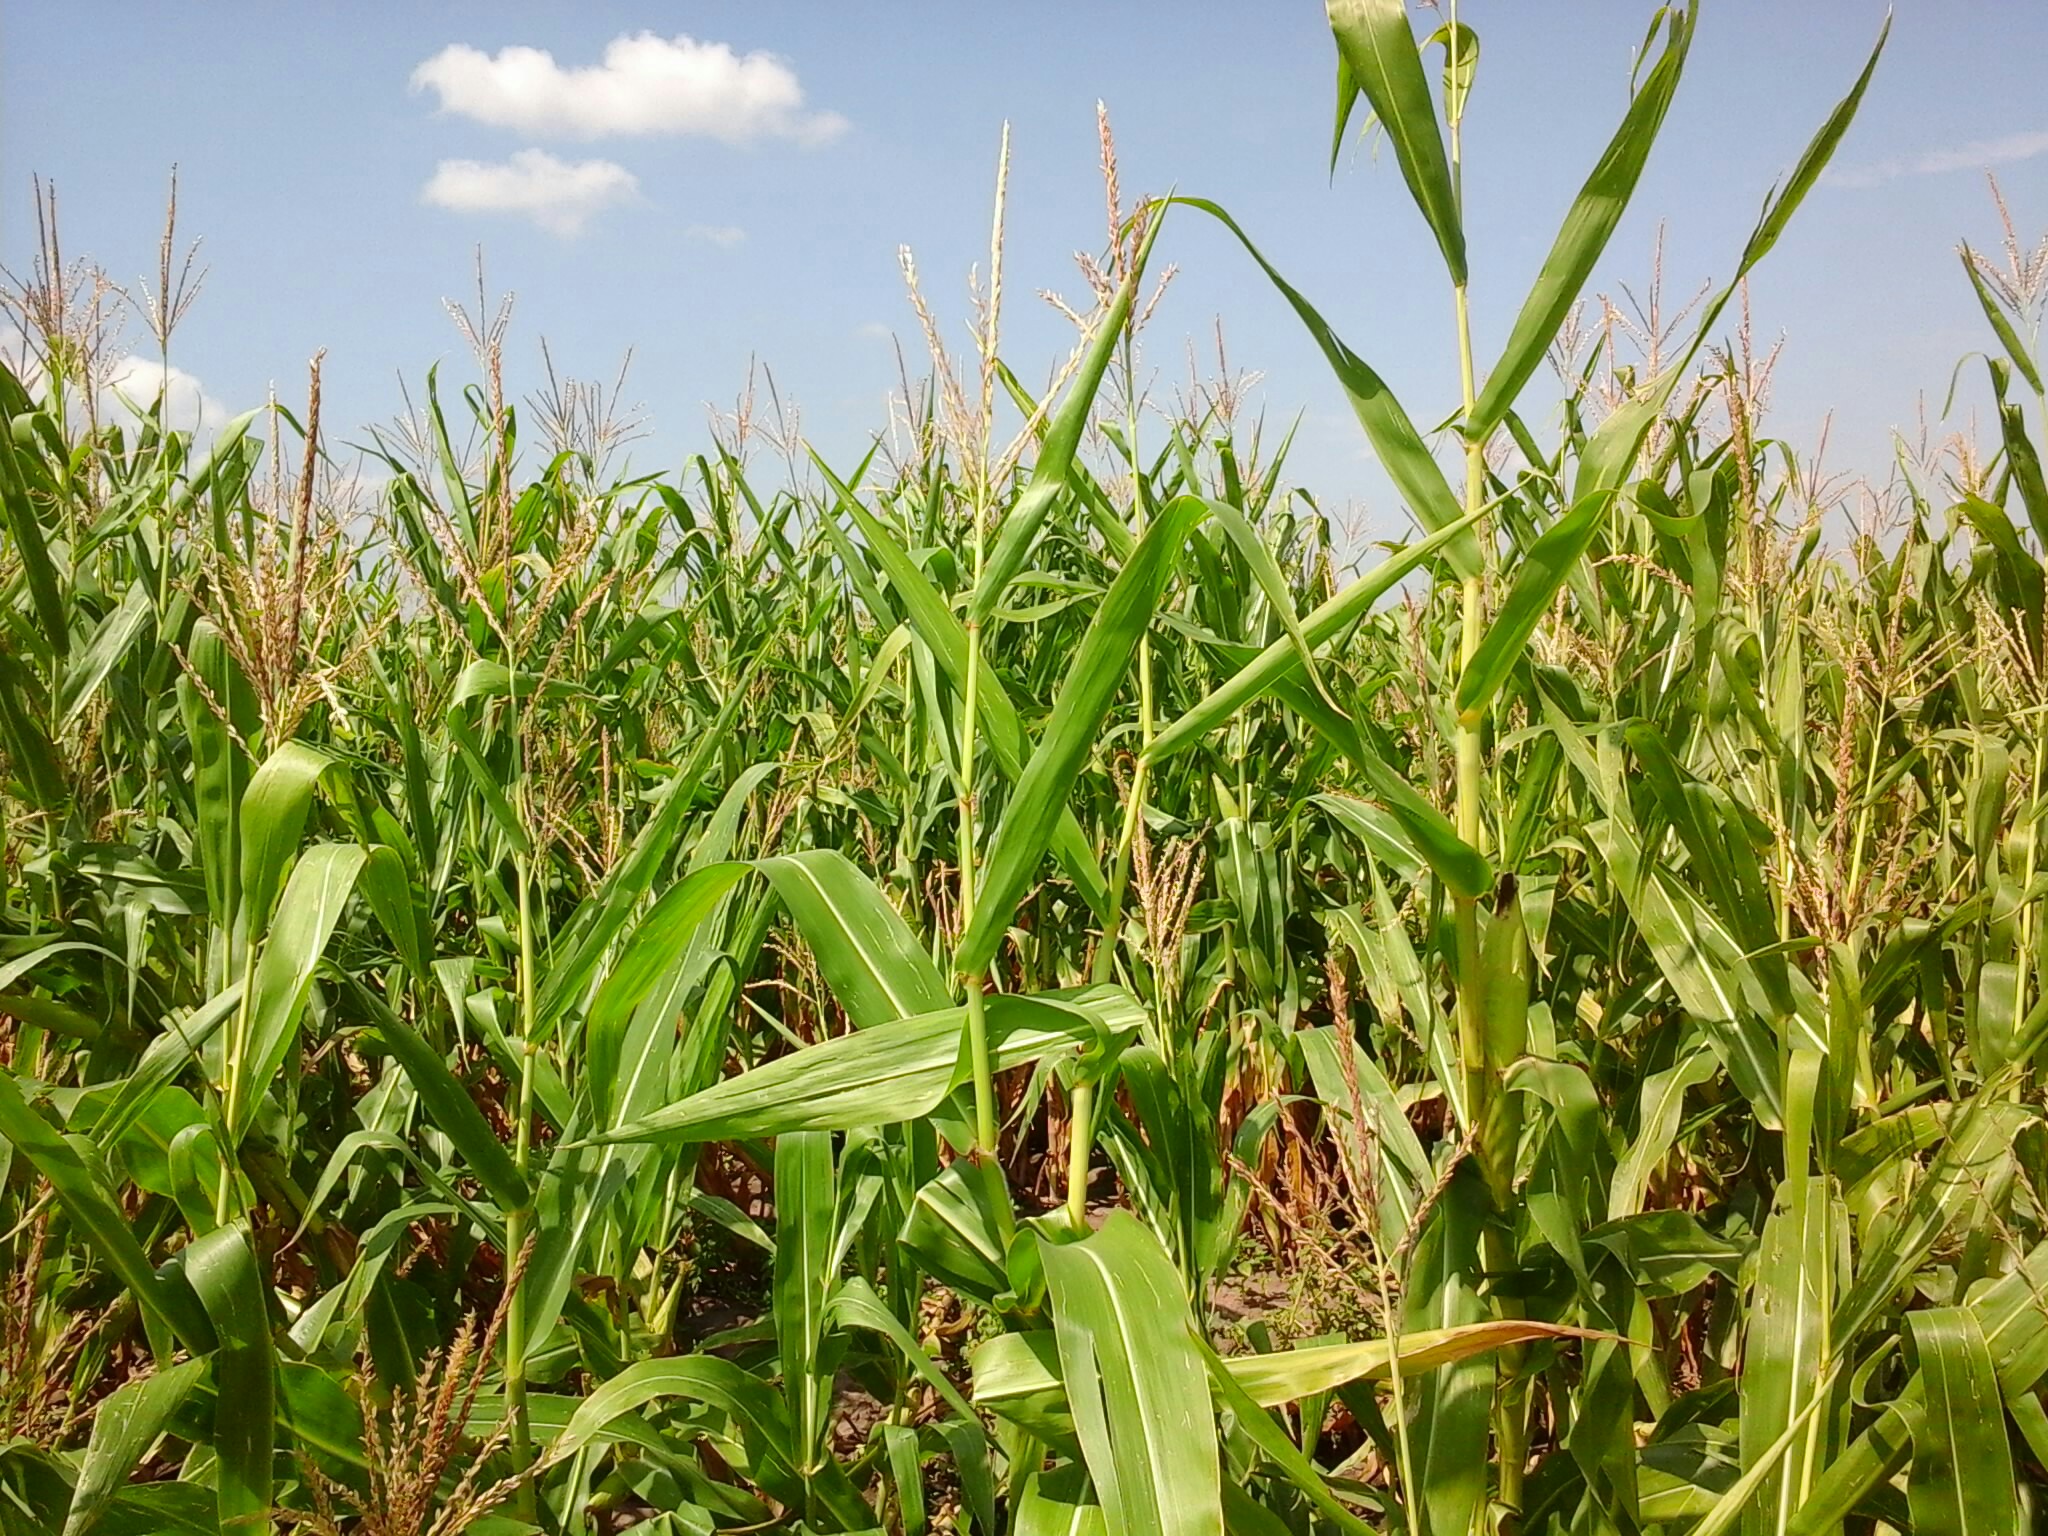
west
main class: Cropland
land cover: Maize
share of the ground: > 75 %
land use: Agriculture (excluding fallow land and kitchen gardens)
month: August
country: HU
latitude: 47.6007
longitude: 18.3259
